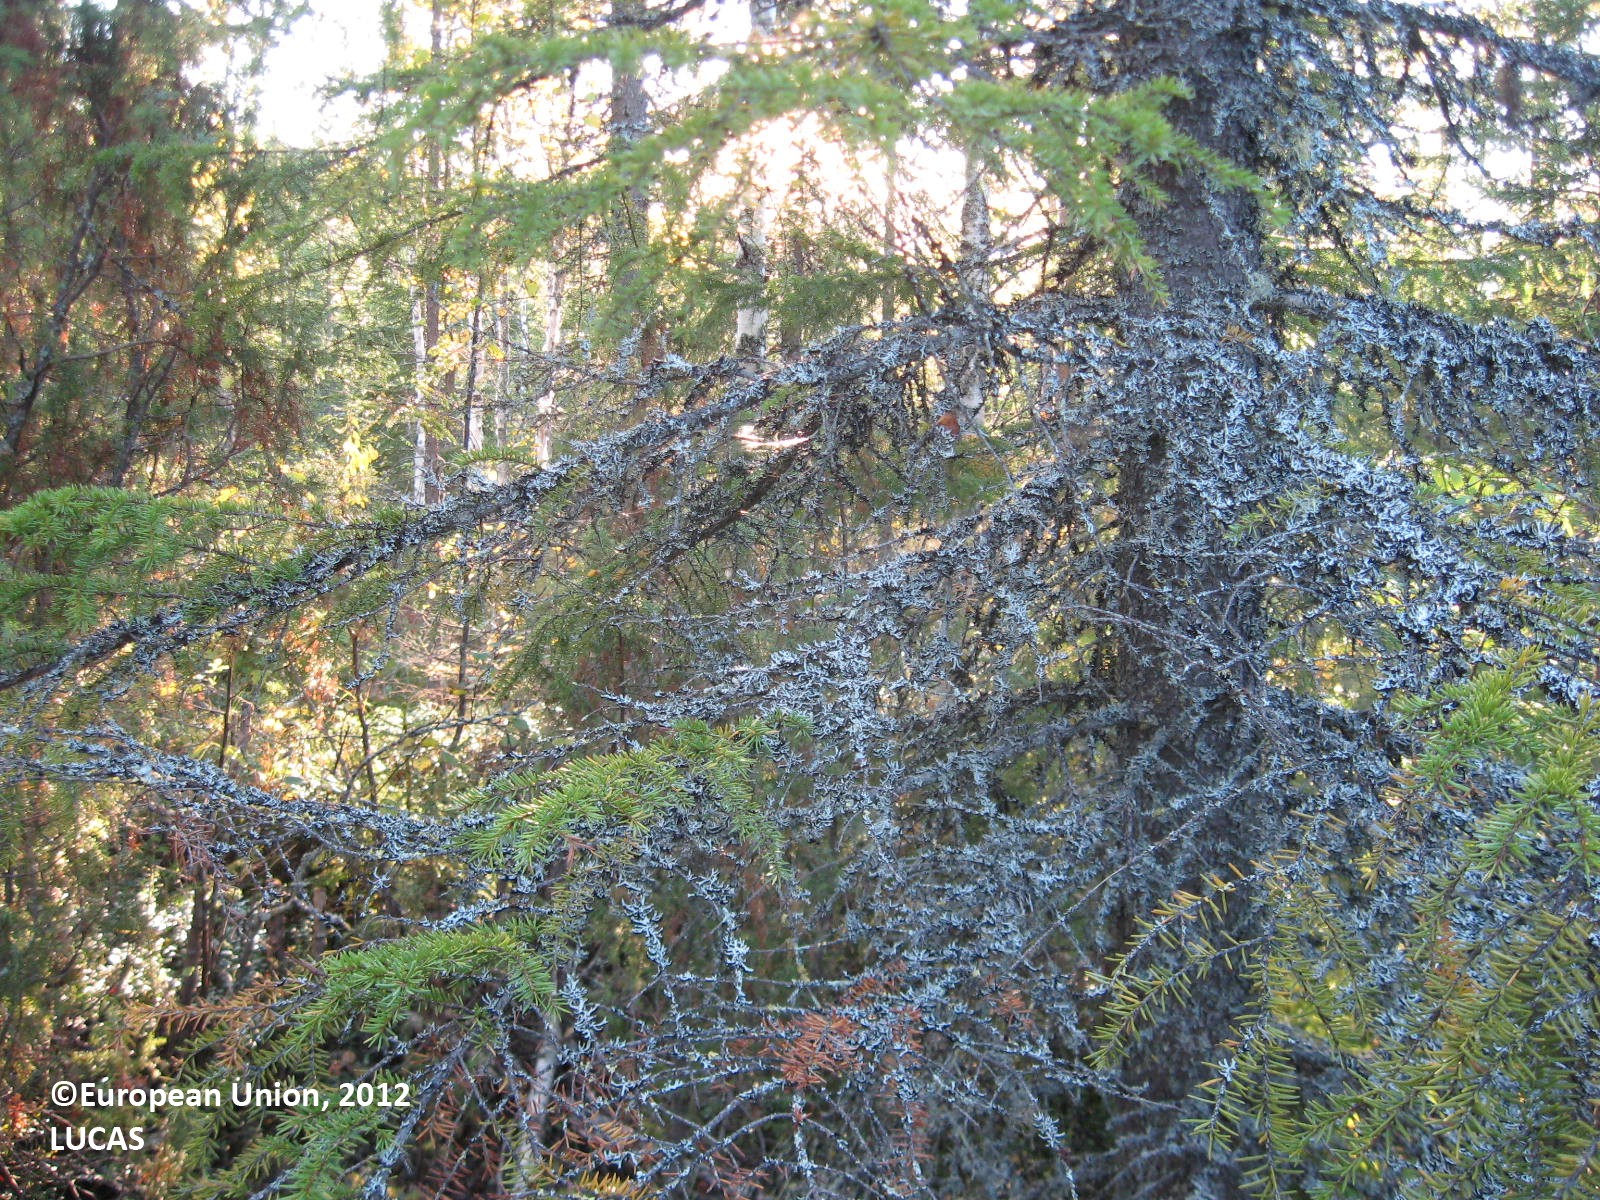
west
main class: Woodland
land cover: Spruce dominated mixed woodland
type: boreal forest
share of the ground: > 75 %
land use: Forestry
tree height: > 5 m
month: August
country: FI
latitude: 63.8567
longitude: 29.8248
